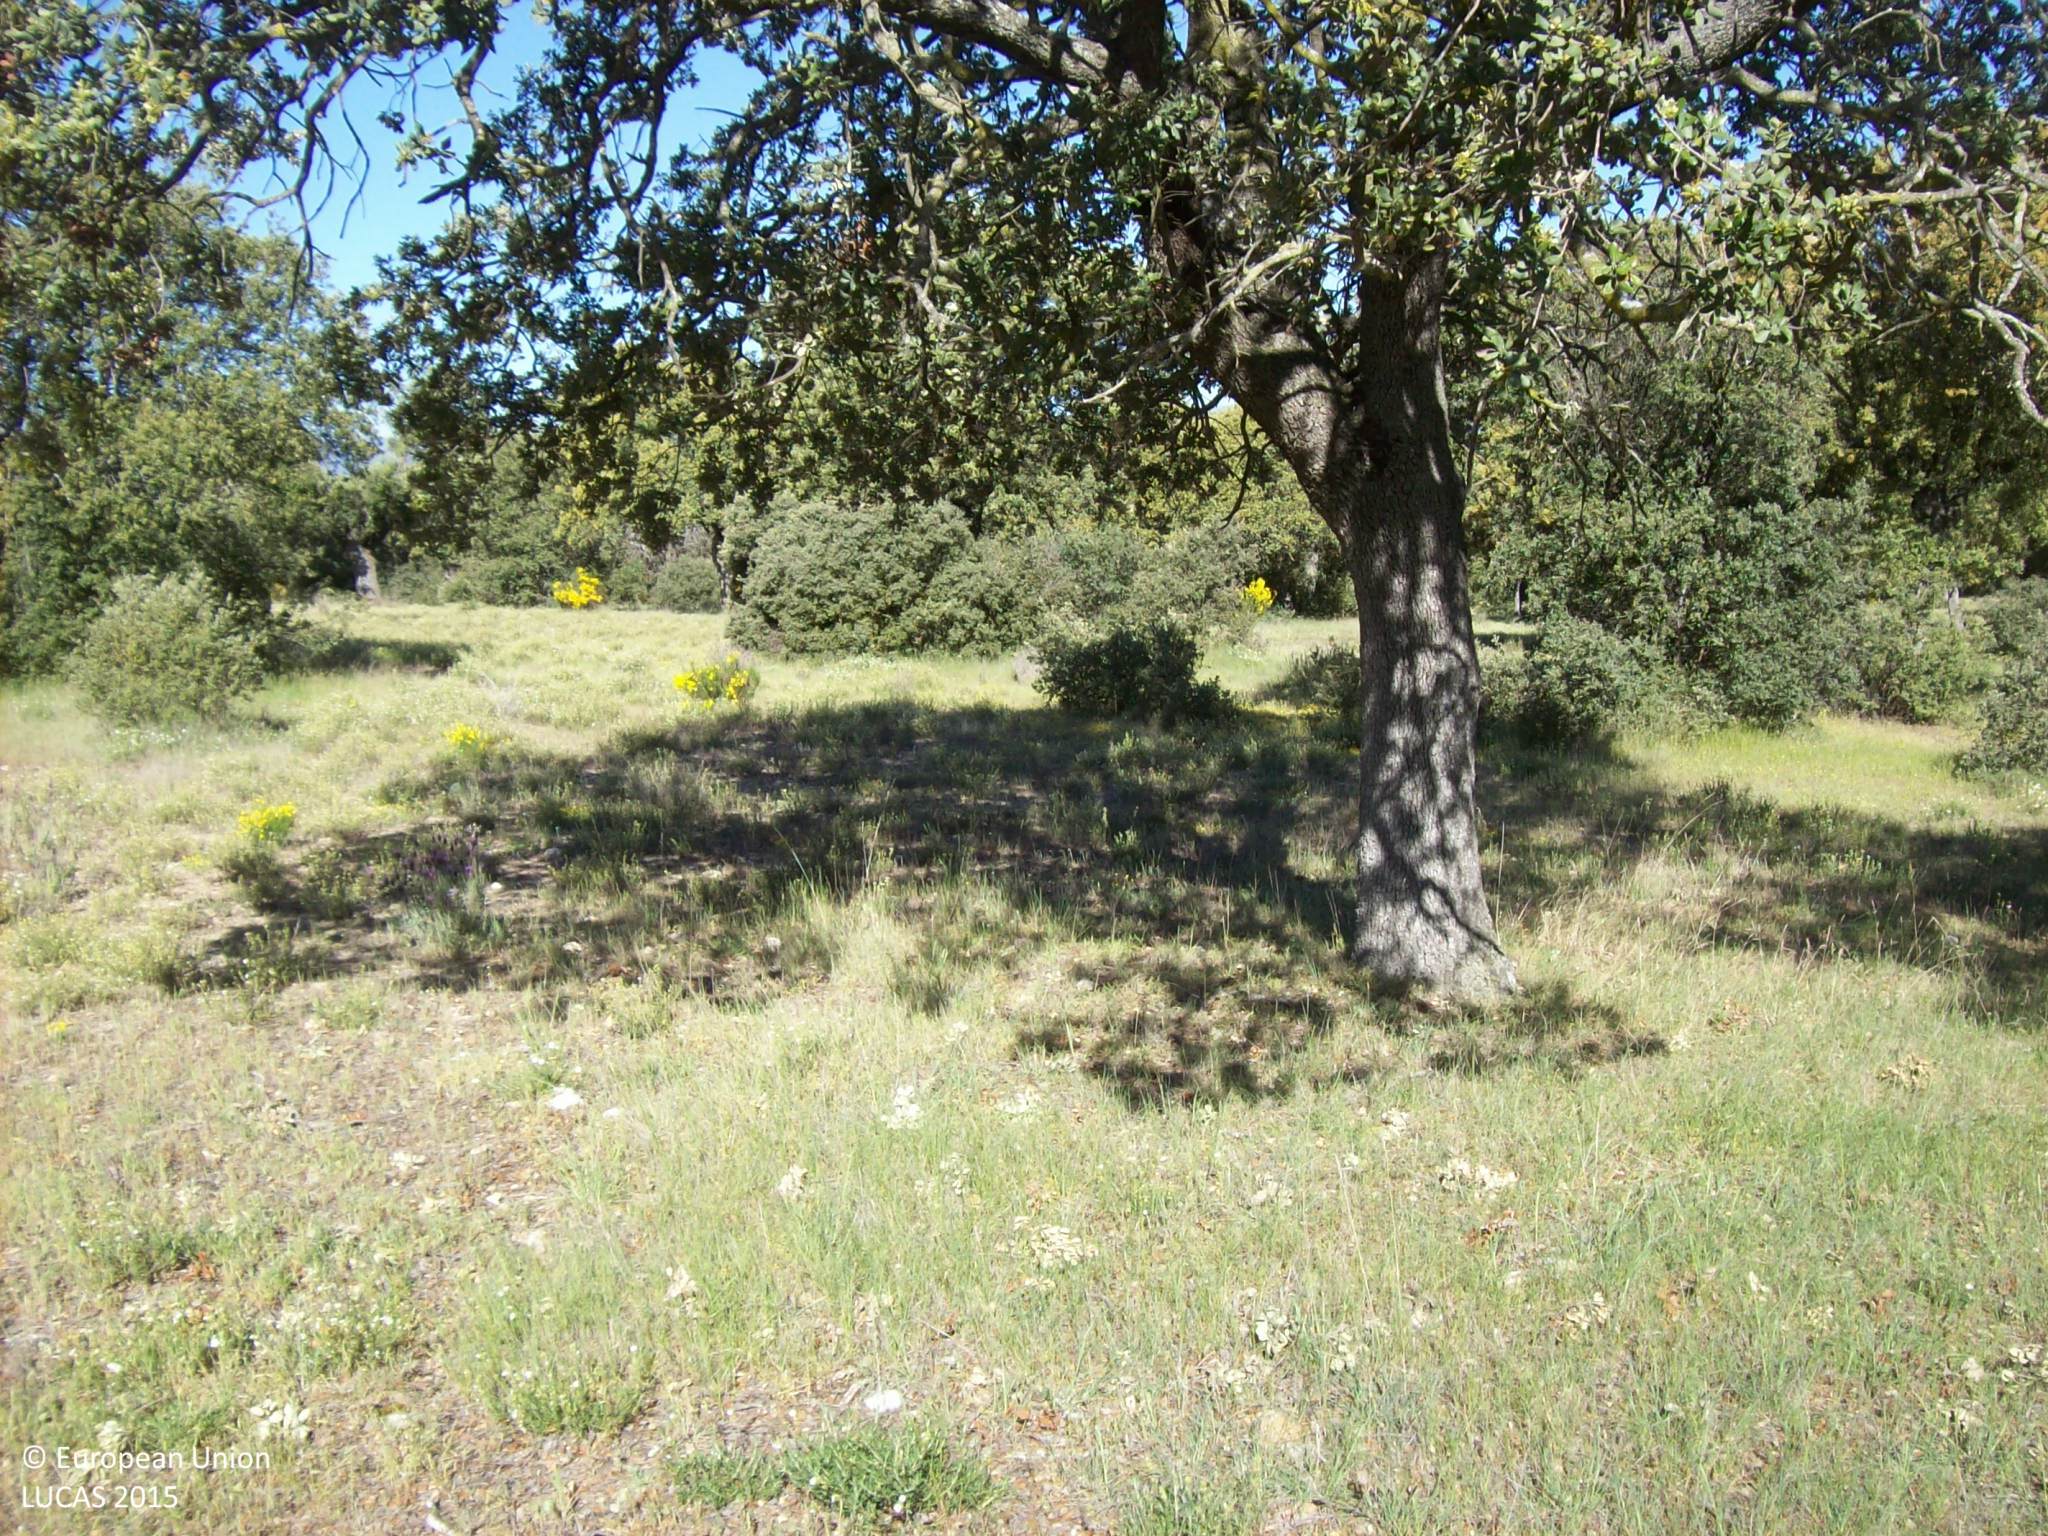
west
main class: Woodland
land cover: Broadleaved woodland
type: broadleaved evergreen forest
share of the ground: 25 - 50 %
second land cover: Grassland without tree/shrub cover
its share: 50 - 75 %
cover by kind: herbaceous plants 65 %, broadleaved forest trees 30 %, shrubs 5 %
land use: Forestry
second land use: Agriculture (excluding fallow land and kitchen gardens)
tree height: > 5 m
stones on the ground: 10 - 25 %
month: May
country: ES
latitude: 40.5682
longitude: -4.9291
